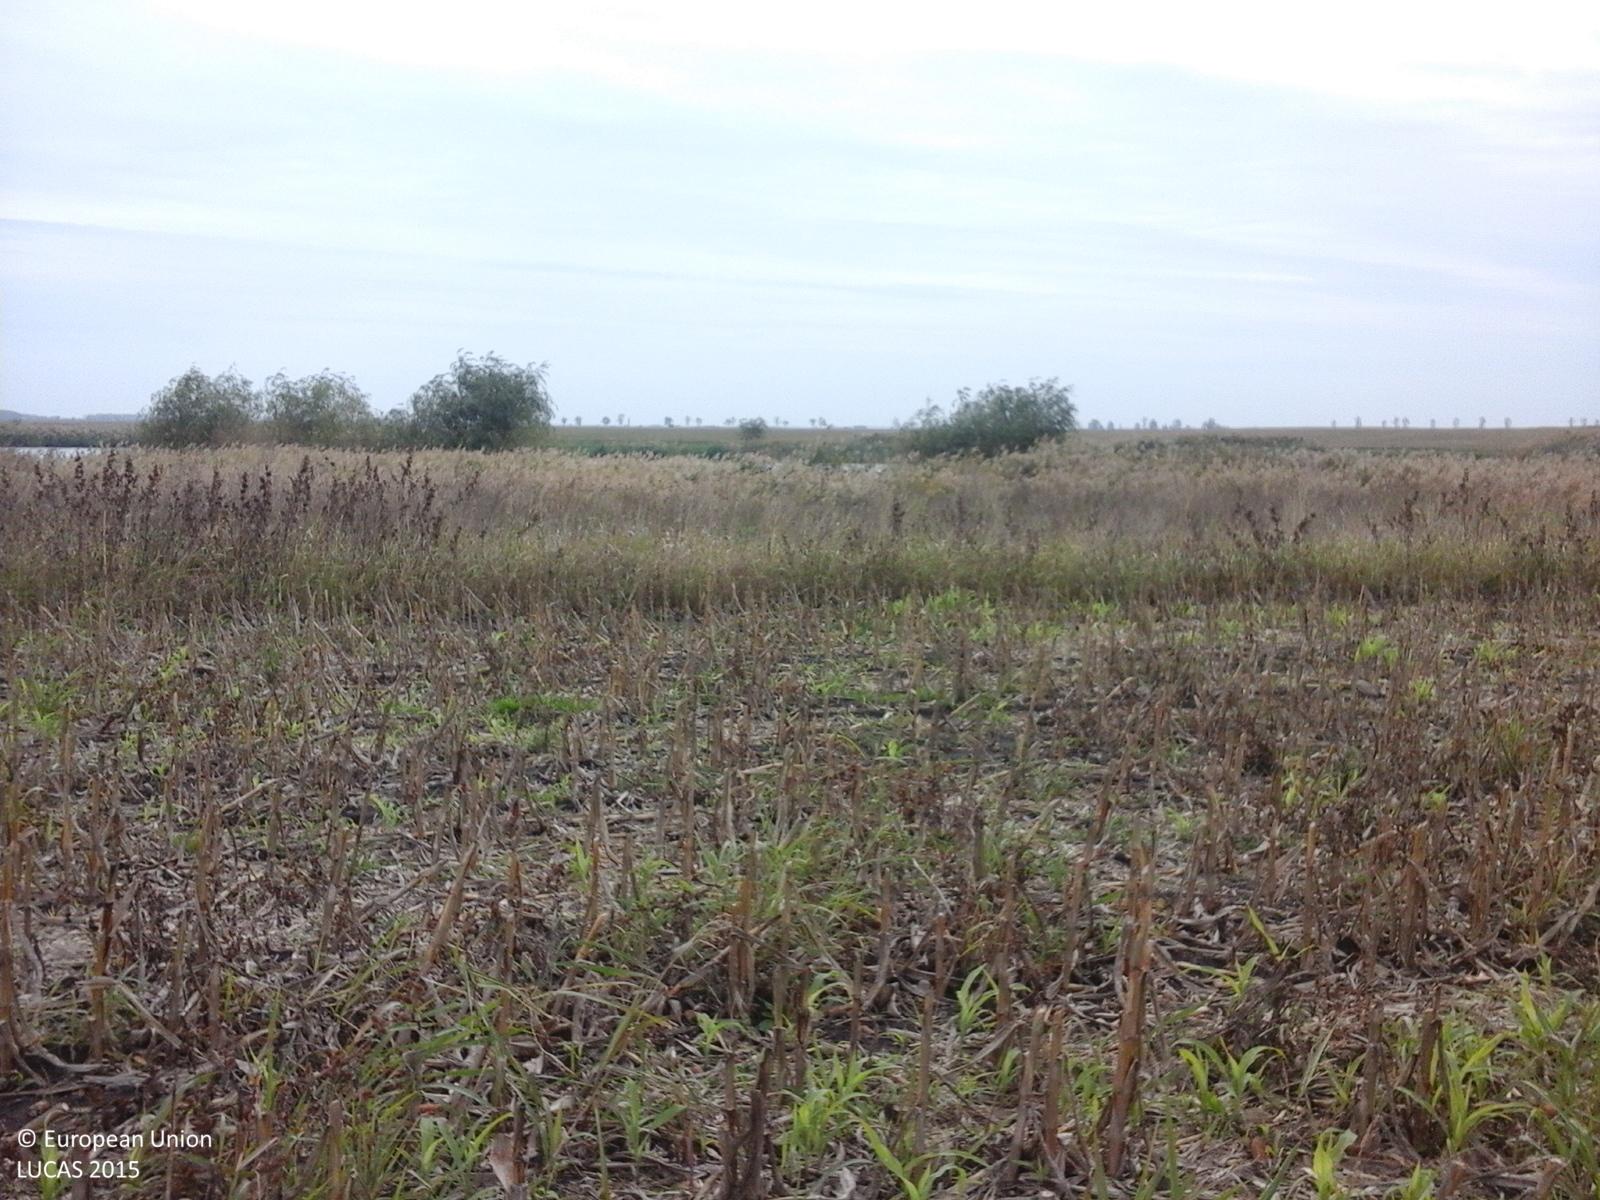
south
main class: Cropland
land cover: Maize
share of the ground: 25 - 50 %
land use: Agriculture (excluding fallow land and kitchen gardens)
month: October
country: RO
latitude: 44.9219
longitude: 26.3186
